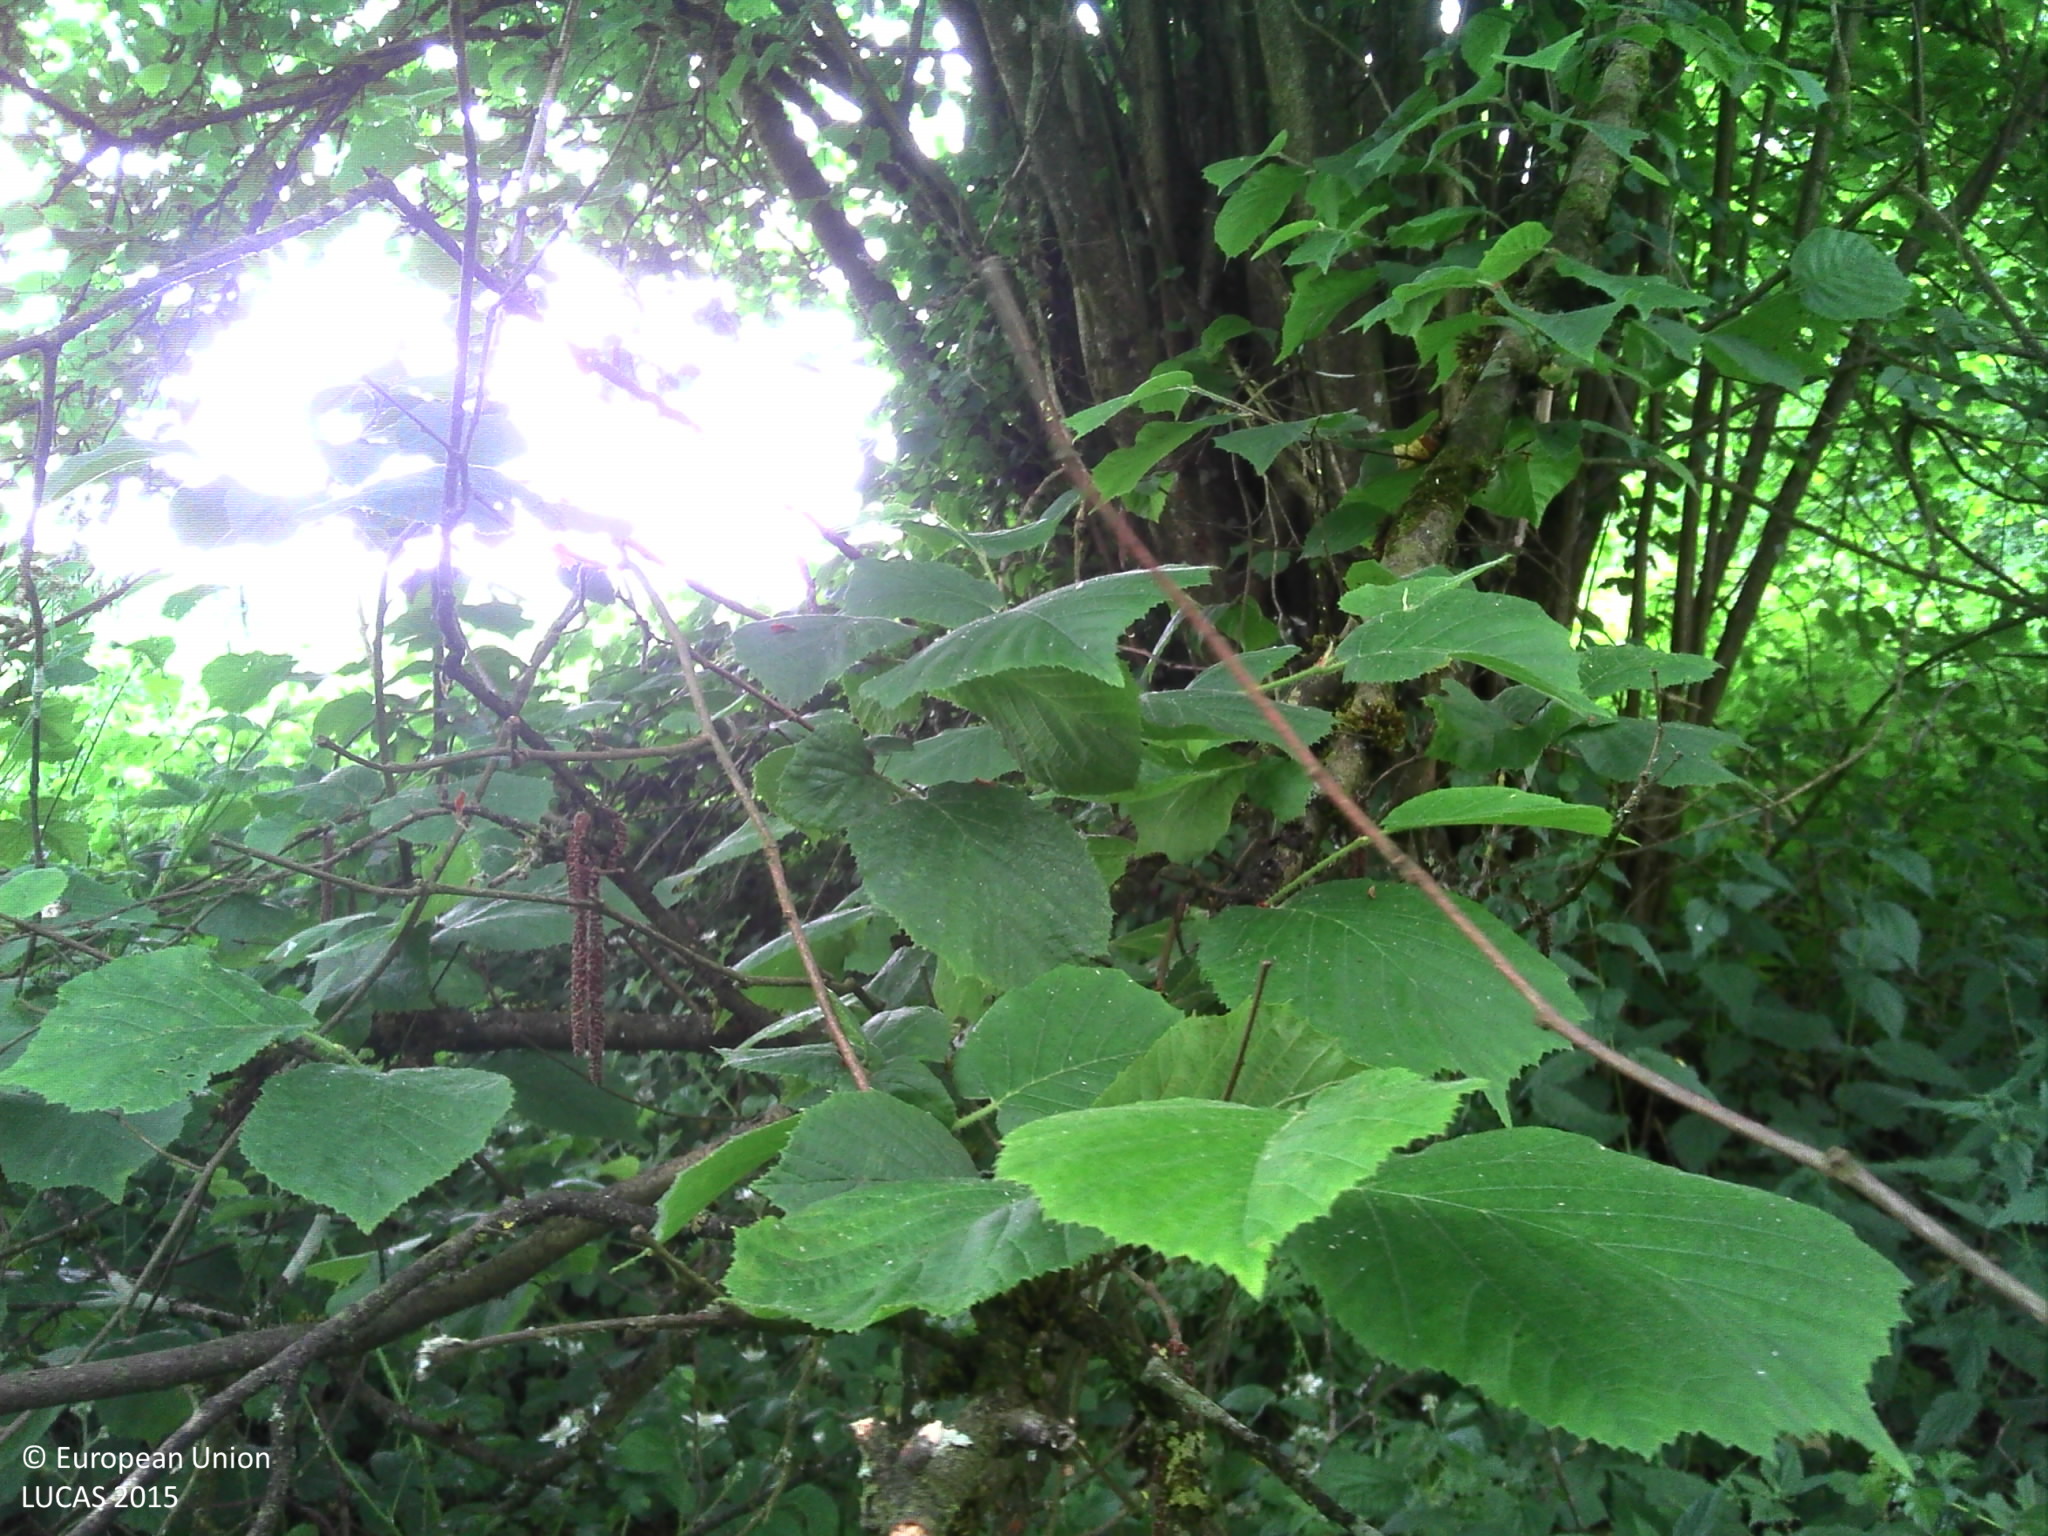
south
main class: Woodland
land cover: Broadleaved woodland
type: mesophytic deciduous forest
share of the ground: > 75 %
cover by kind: broadleaved forest trees 60 %, herbaceous plants 25 %, shrubs 15 %
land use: Forestry
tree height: > 5 m
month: June
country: BE
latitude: 50.3650
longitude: 5.4855
